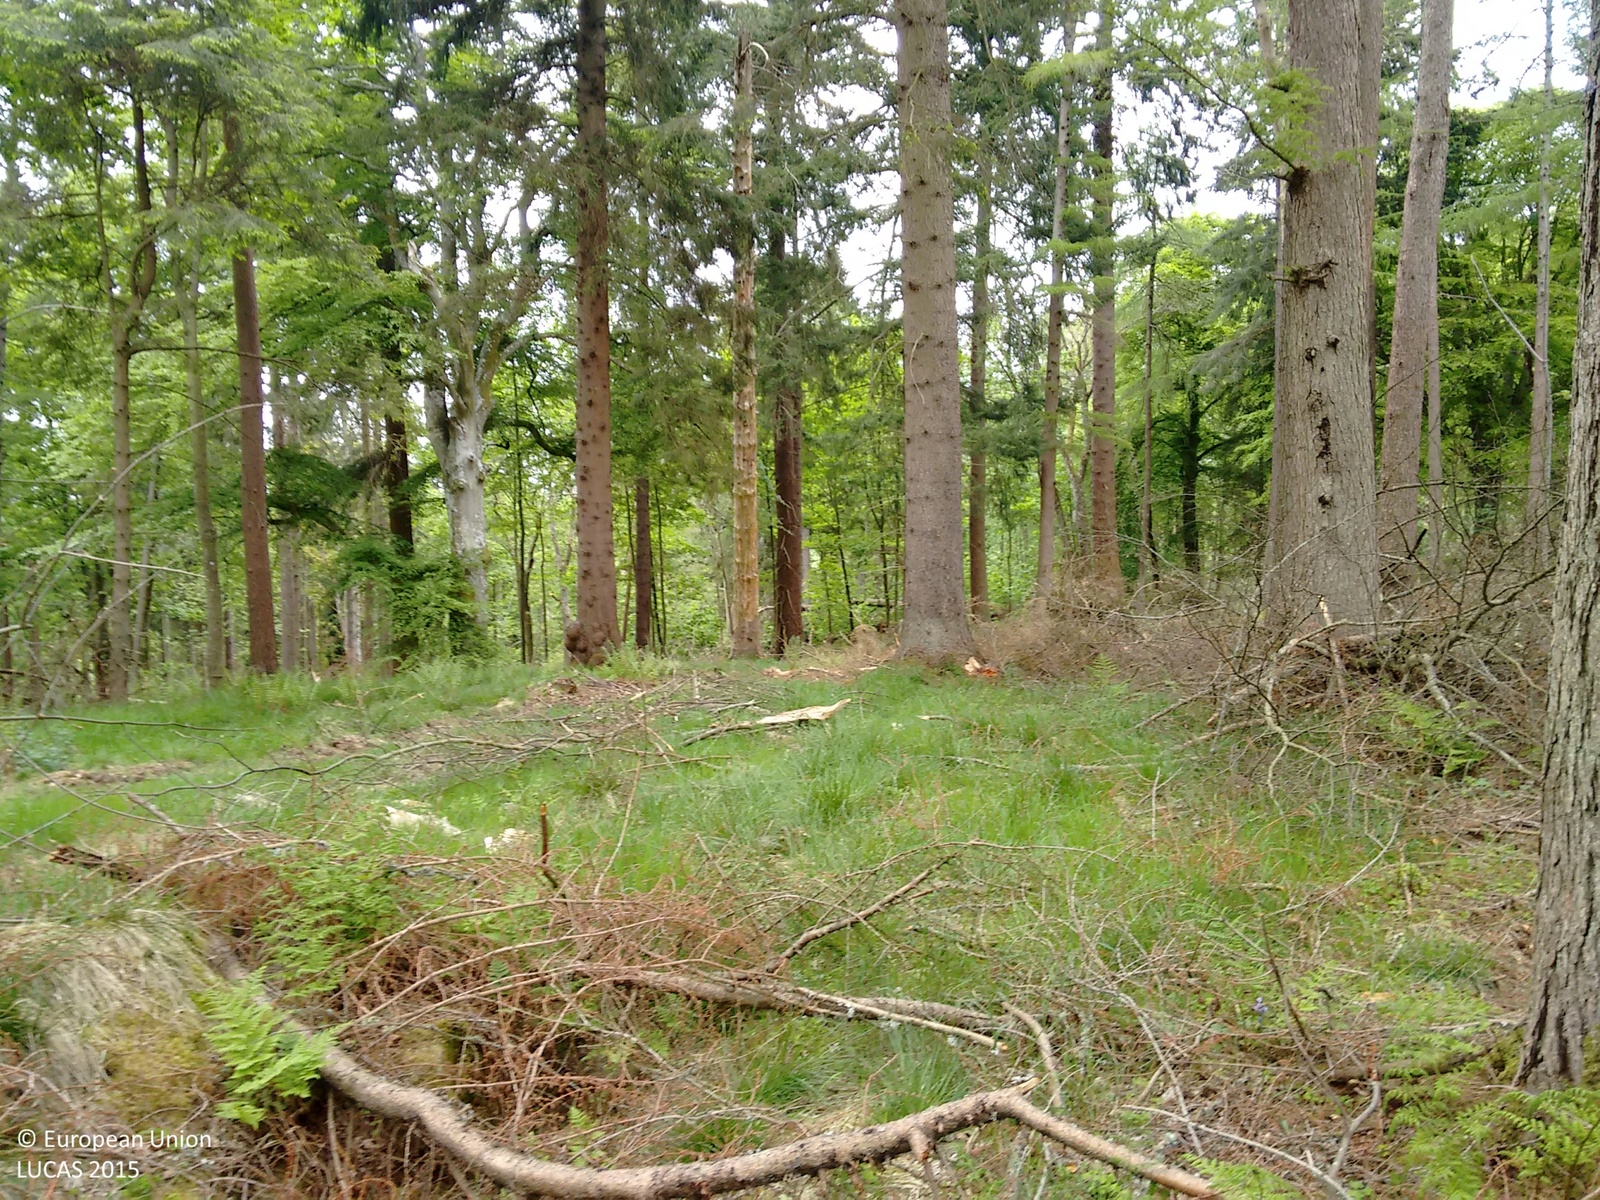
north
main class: Woodland
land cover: Other mixed woodland
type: hemiboreal forest and nemoral coniferous forest and mixed broadleaved-coniferous forest
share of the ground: > 75 %
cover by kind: broadleaved forest trees 50 %, coniferous forest trees 40 %, herbaceous plants 10 %
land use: Forestry
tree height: > 5 m
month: May
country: GB
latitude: 56.3267
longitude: -3.5147
